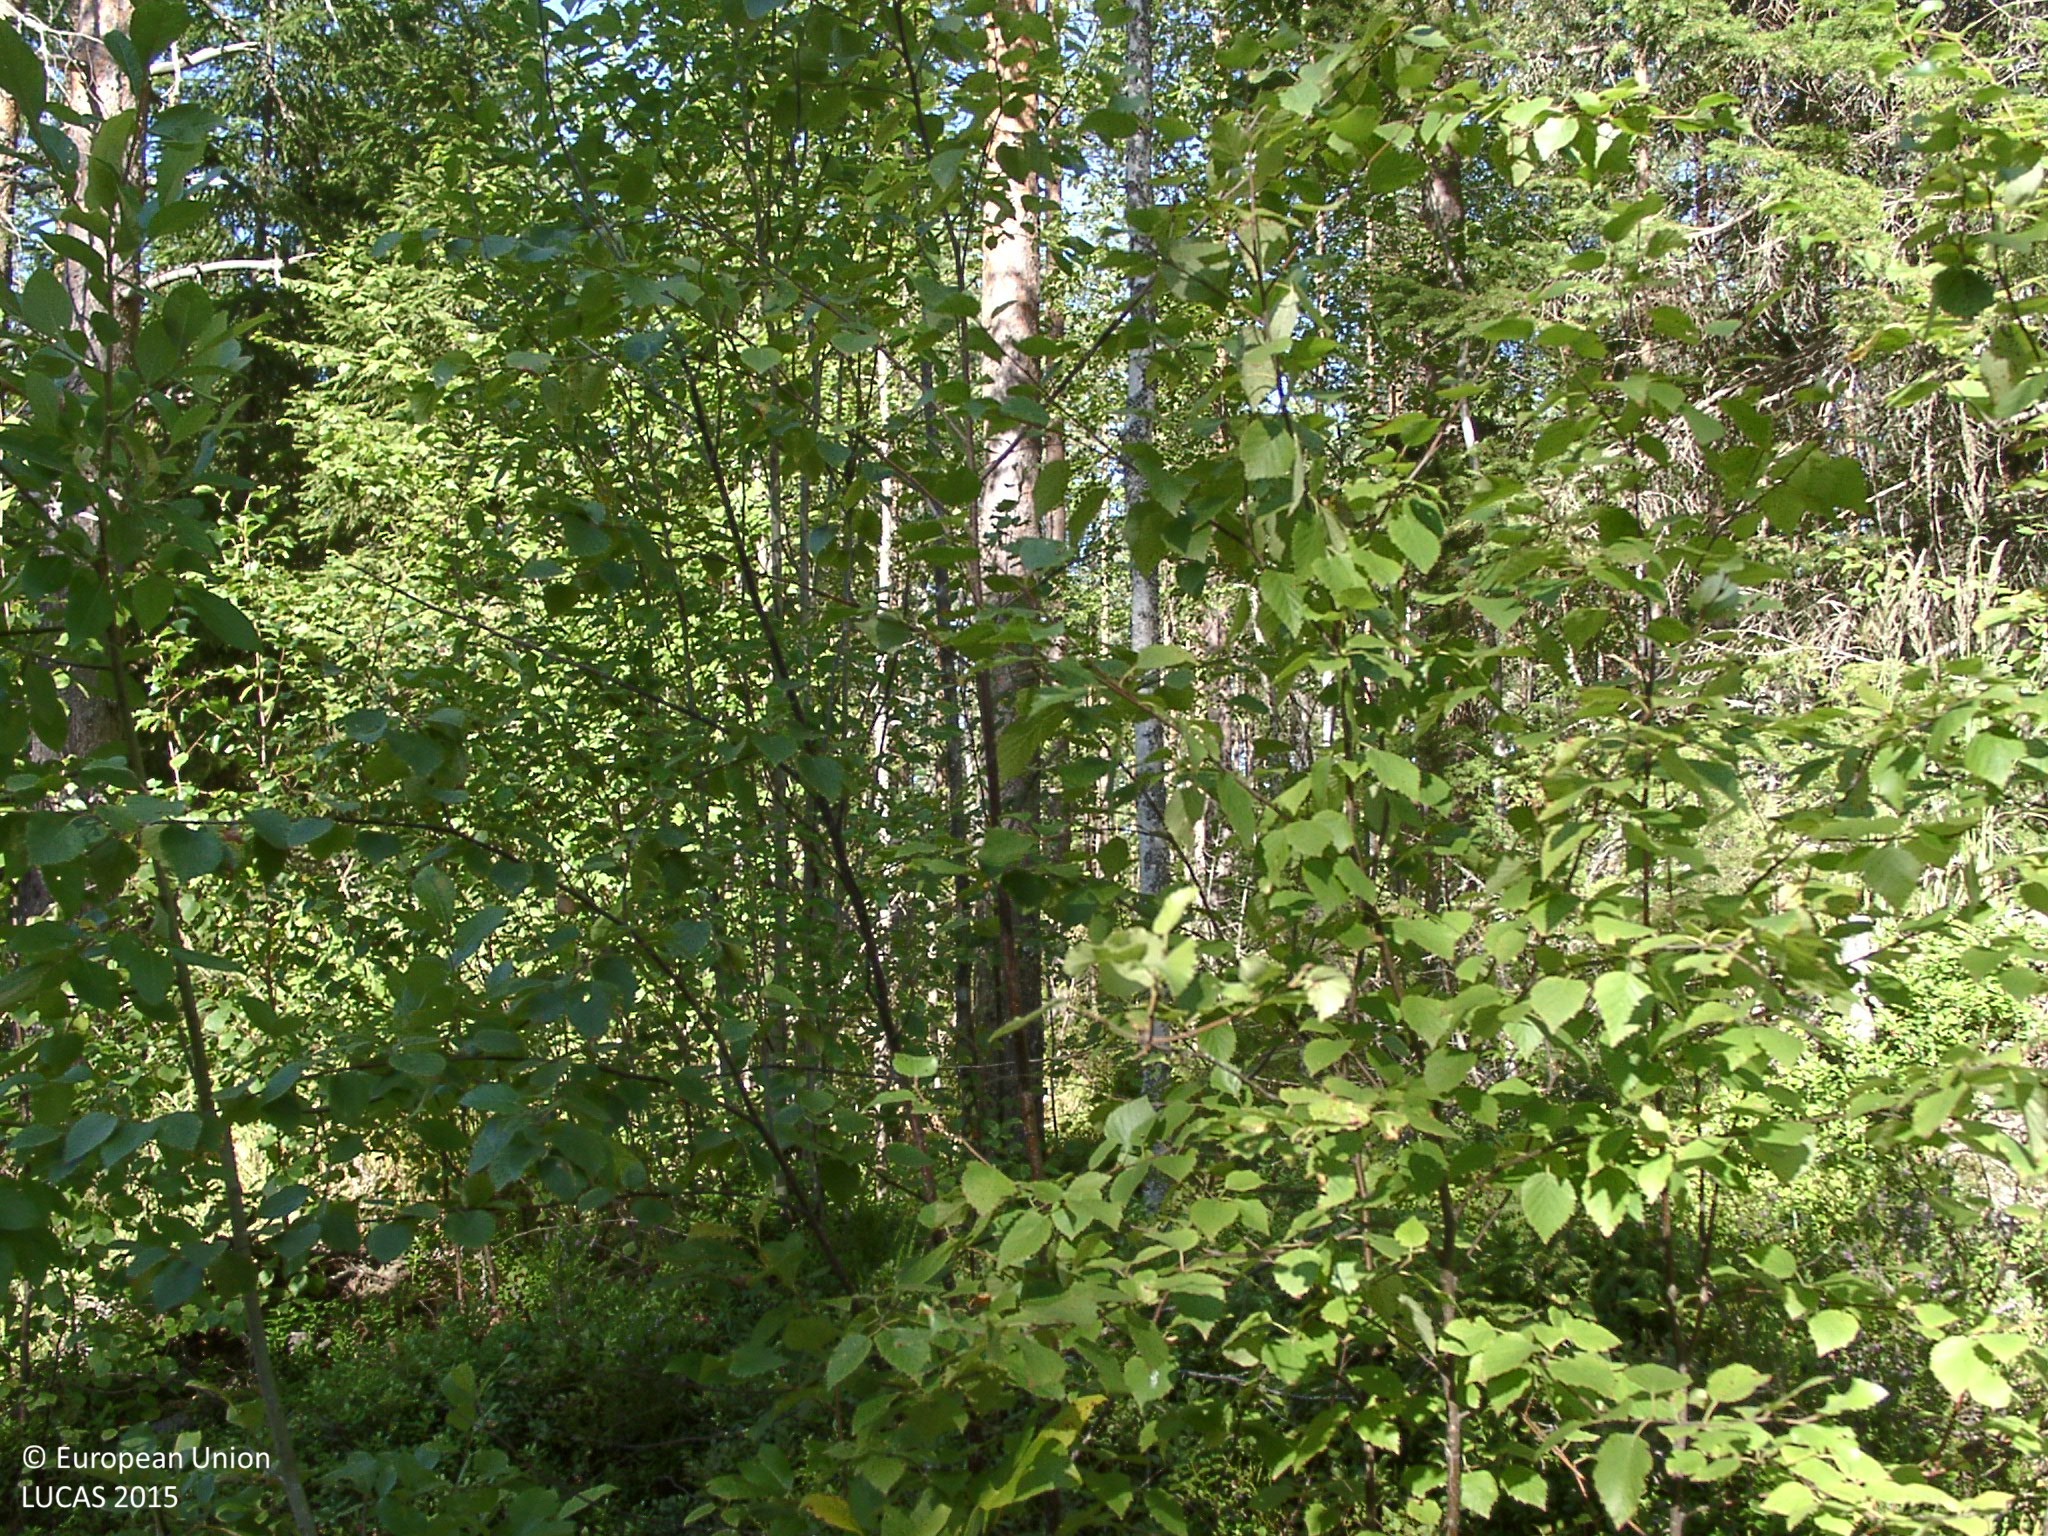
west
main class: Woodland
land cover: Other mixed woodland
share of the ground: 50 - 75 %
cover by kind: coniferous forest trees 45 %, shrubs 25 %, broadleaved forest trees 20 %, herbaceous plants 10 %
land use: Forestry
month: August
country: FI
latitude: 62.3683
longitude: 25.2008
